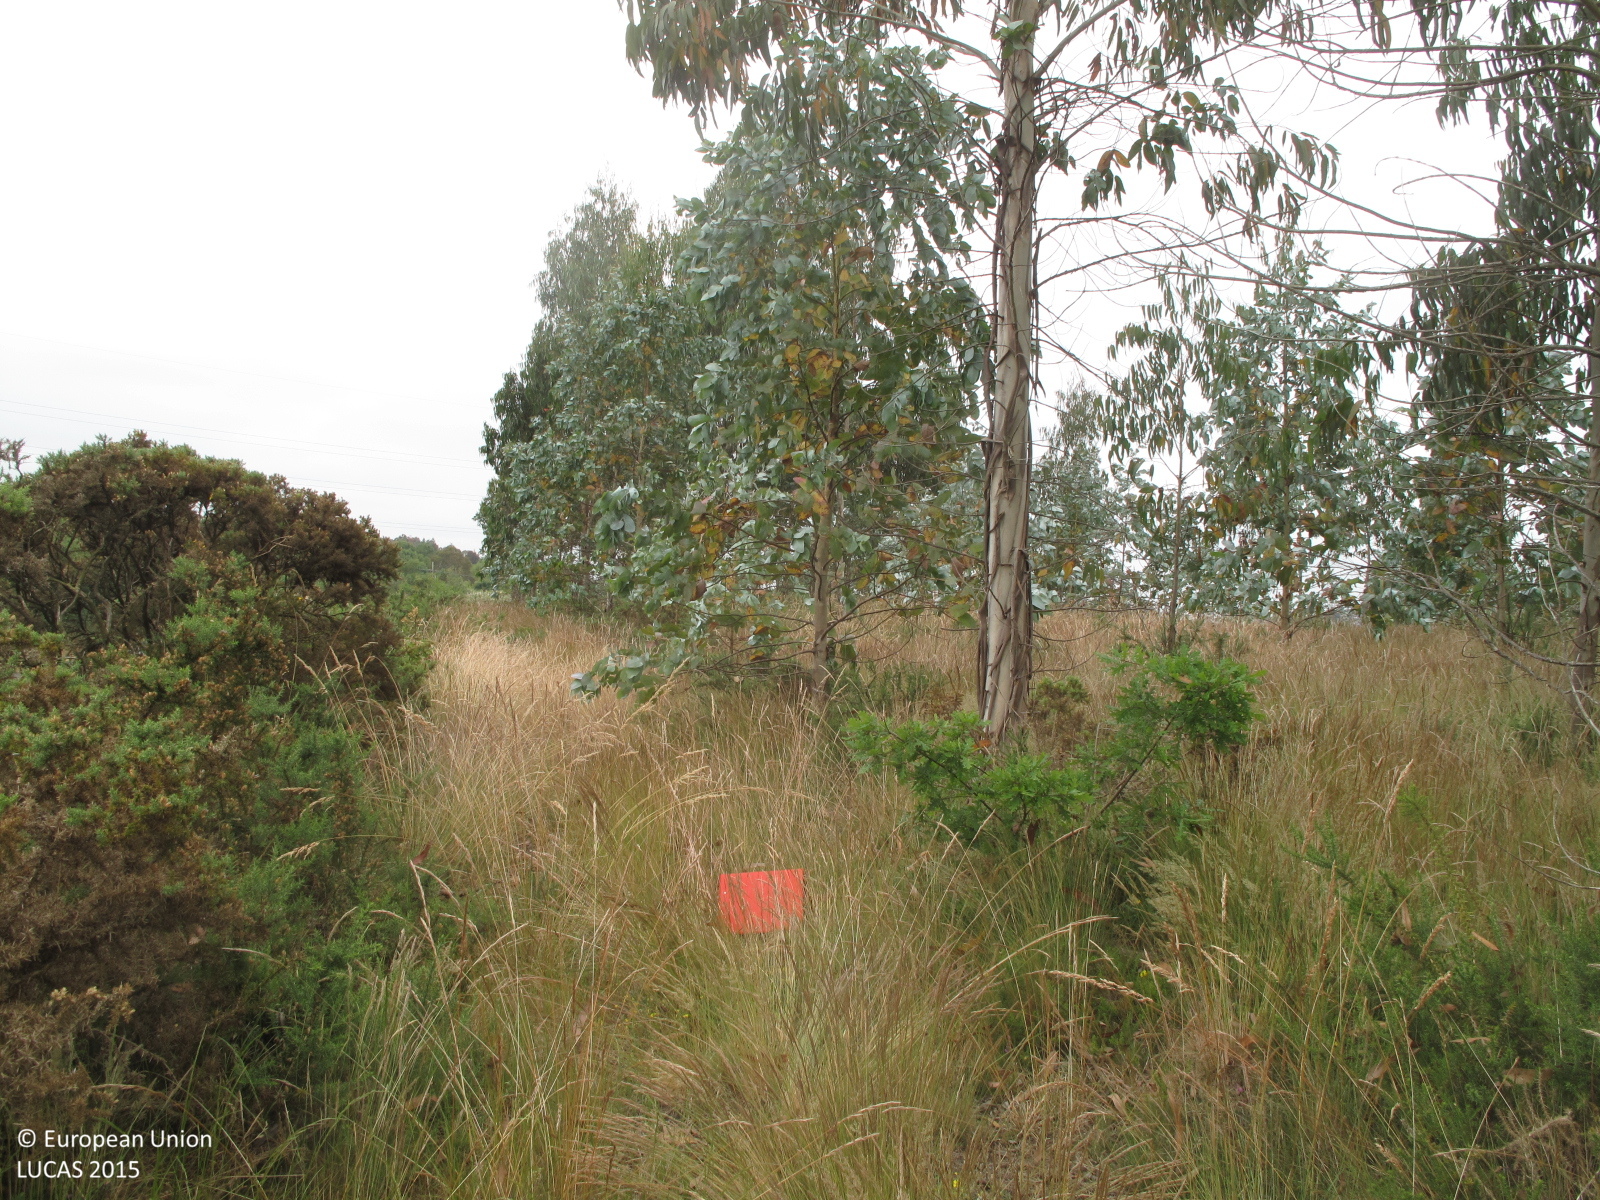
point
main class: Woodland
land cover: Broadleaved woodland
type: exotic forest
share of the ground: 25 - 50 %
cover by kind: herbaceous plants 50 %, broadleaved forest trees 40 %, shrubs 10 %
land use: Forestry
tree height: < 5 m
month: June
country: ES
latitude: 43.1597
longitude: -8.0367
